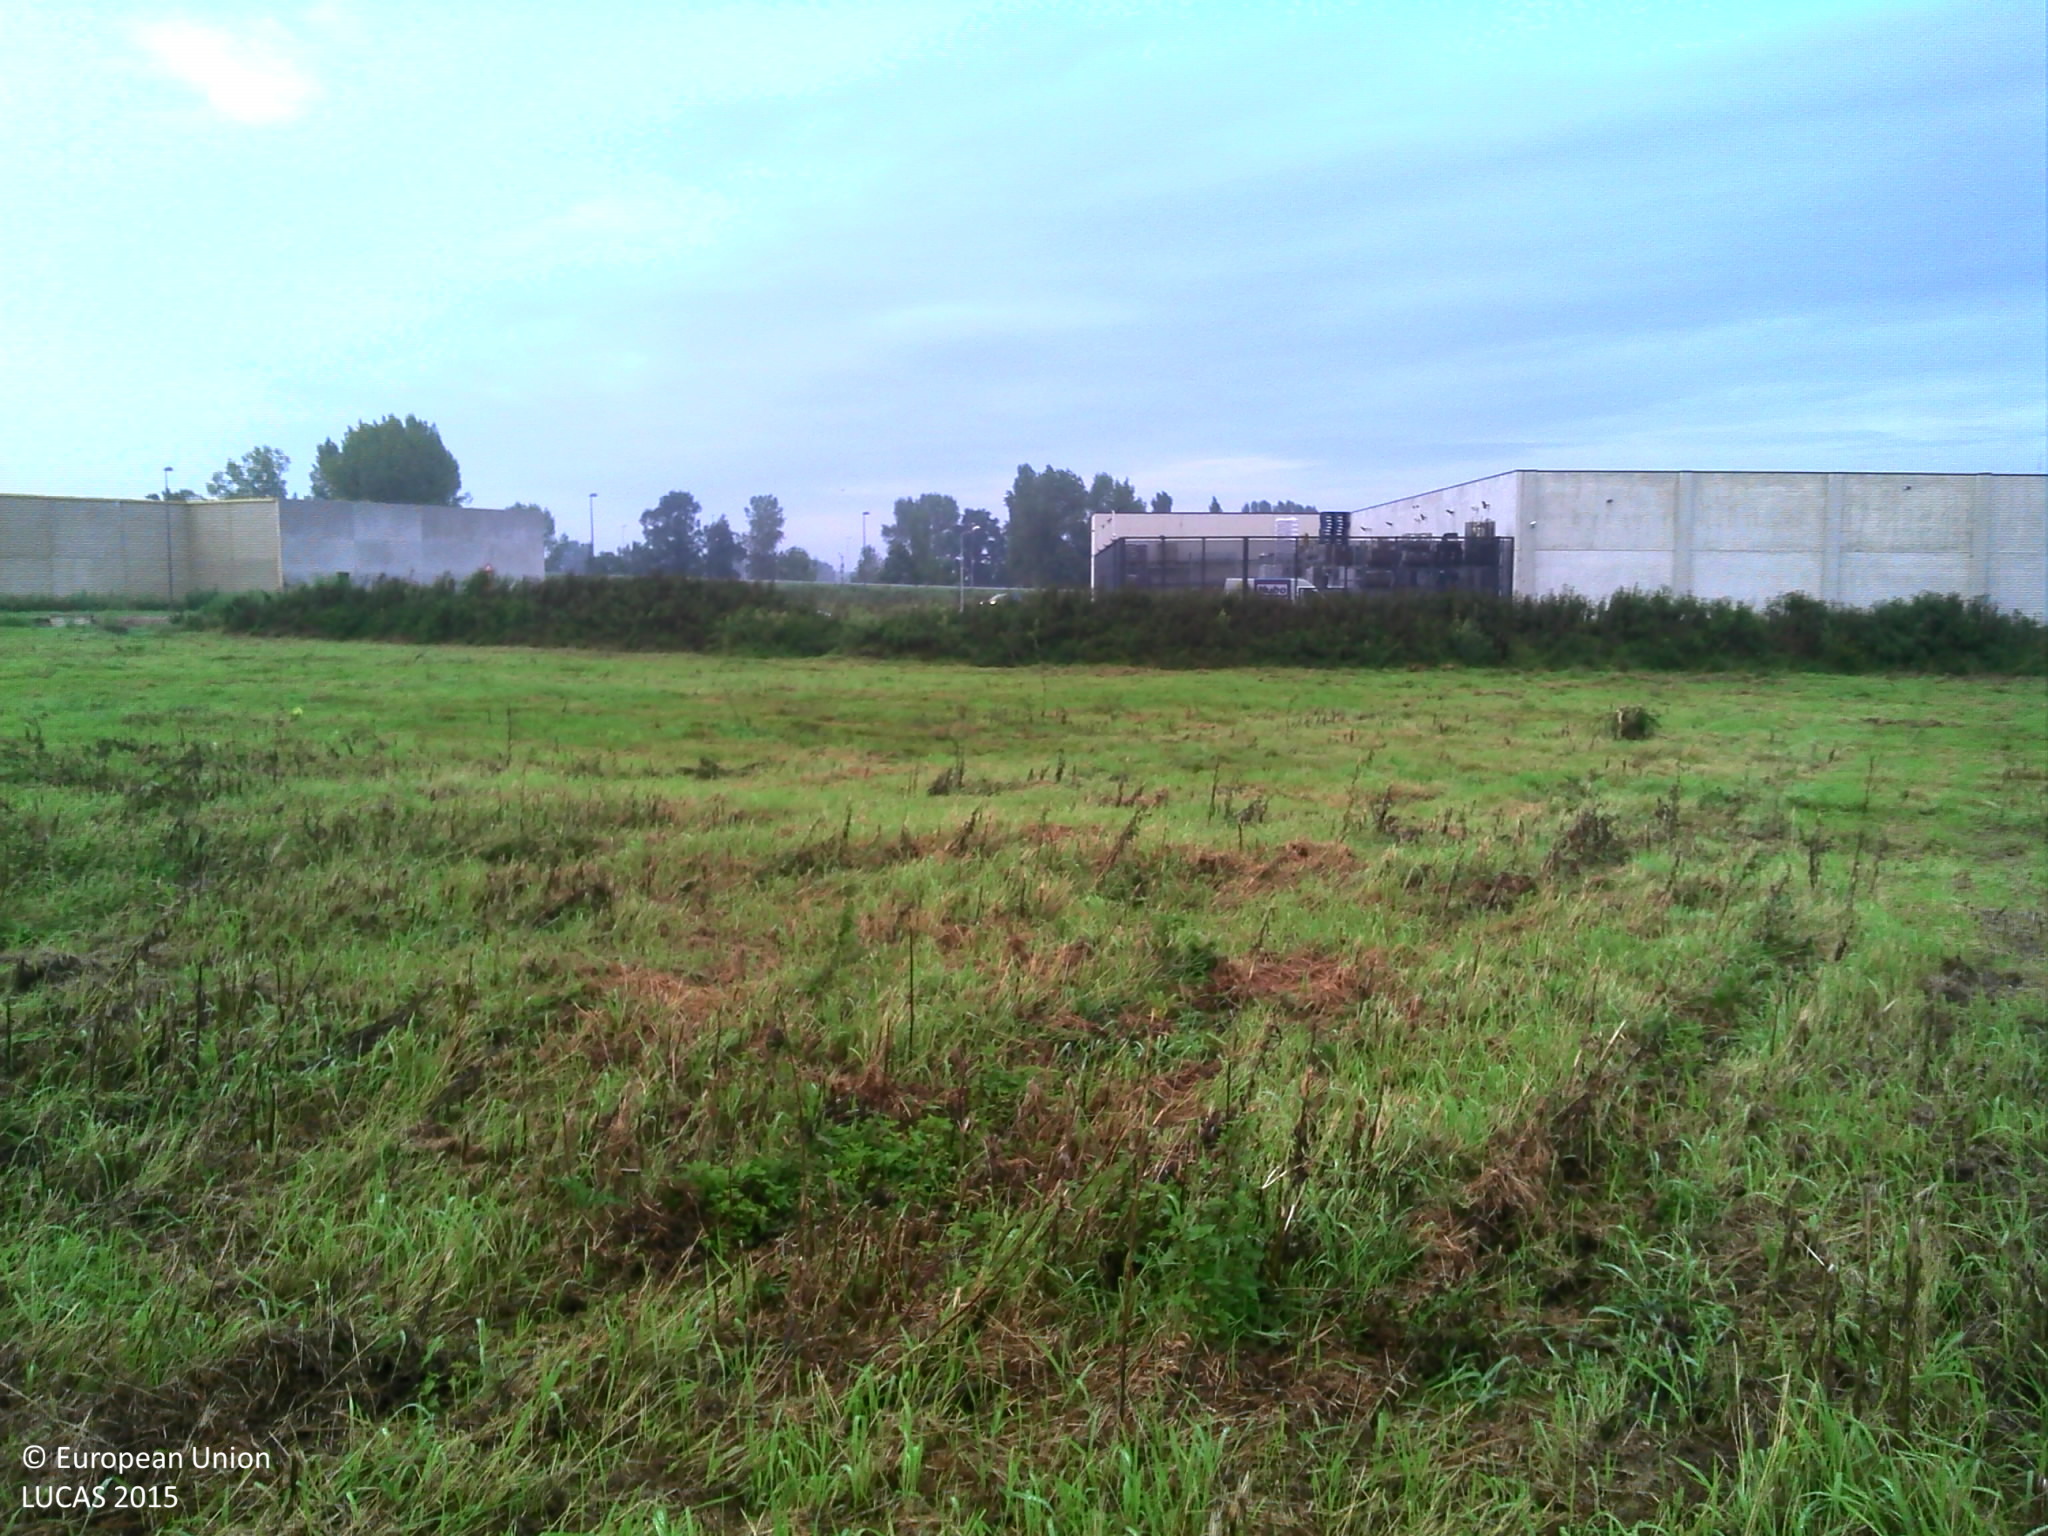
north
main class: Grassland
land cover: Grassland without tree/shrub cover
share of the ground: > 75 %
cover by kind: herbaceous plants 95 %, unconsolidated bare surface 5 %
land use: Agriculture (excluding fallow land and kitchen gardens)
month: September
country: BE
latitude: 51.3556
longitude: 4.6399
